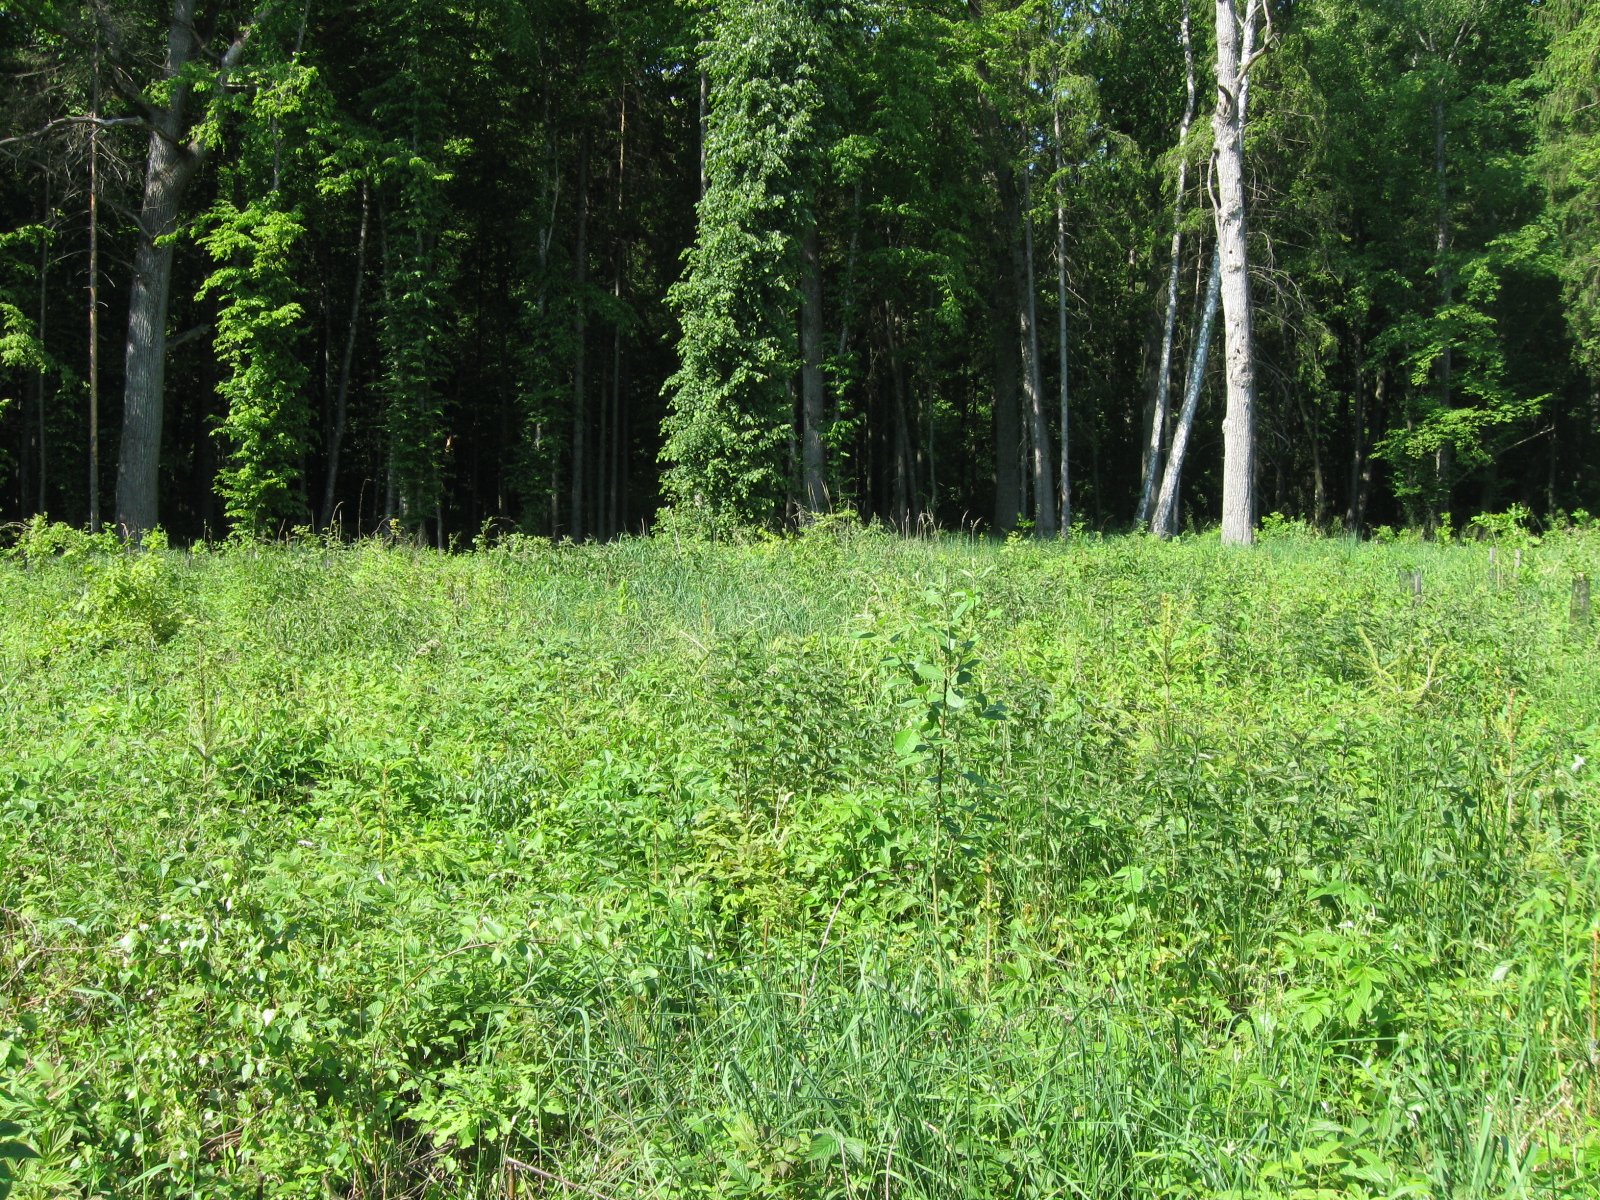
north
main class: Woodland
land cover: Broadleaved woodland
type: non-riverine alder, birch or aspen forest
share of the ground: 10 - 25 %
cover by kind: herbaceous plants 70 %, broadleaved forest trees 15 %, shrubs 10 %, coniferous forest trees 5 %
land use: Forestry
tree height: < 5 m
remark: Nursery
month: June
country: LT
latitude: 54.2682
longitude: 23.8000
